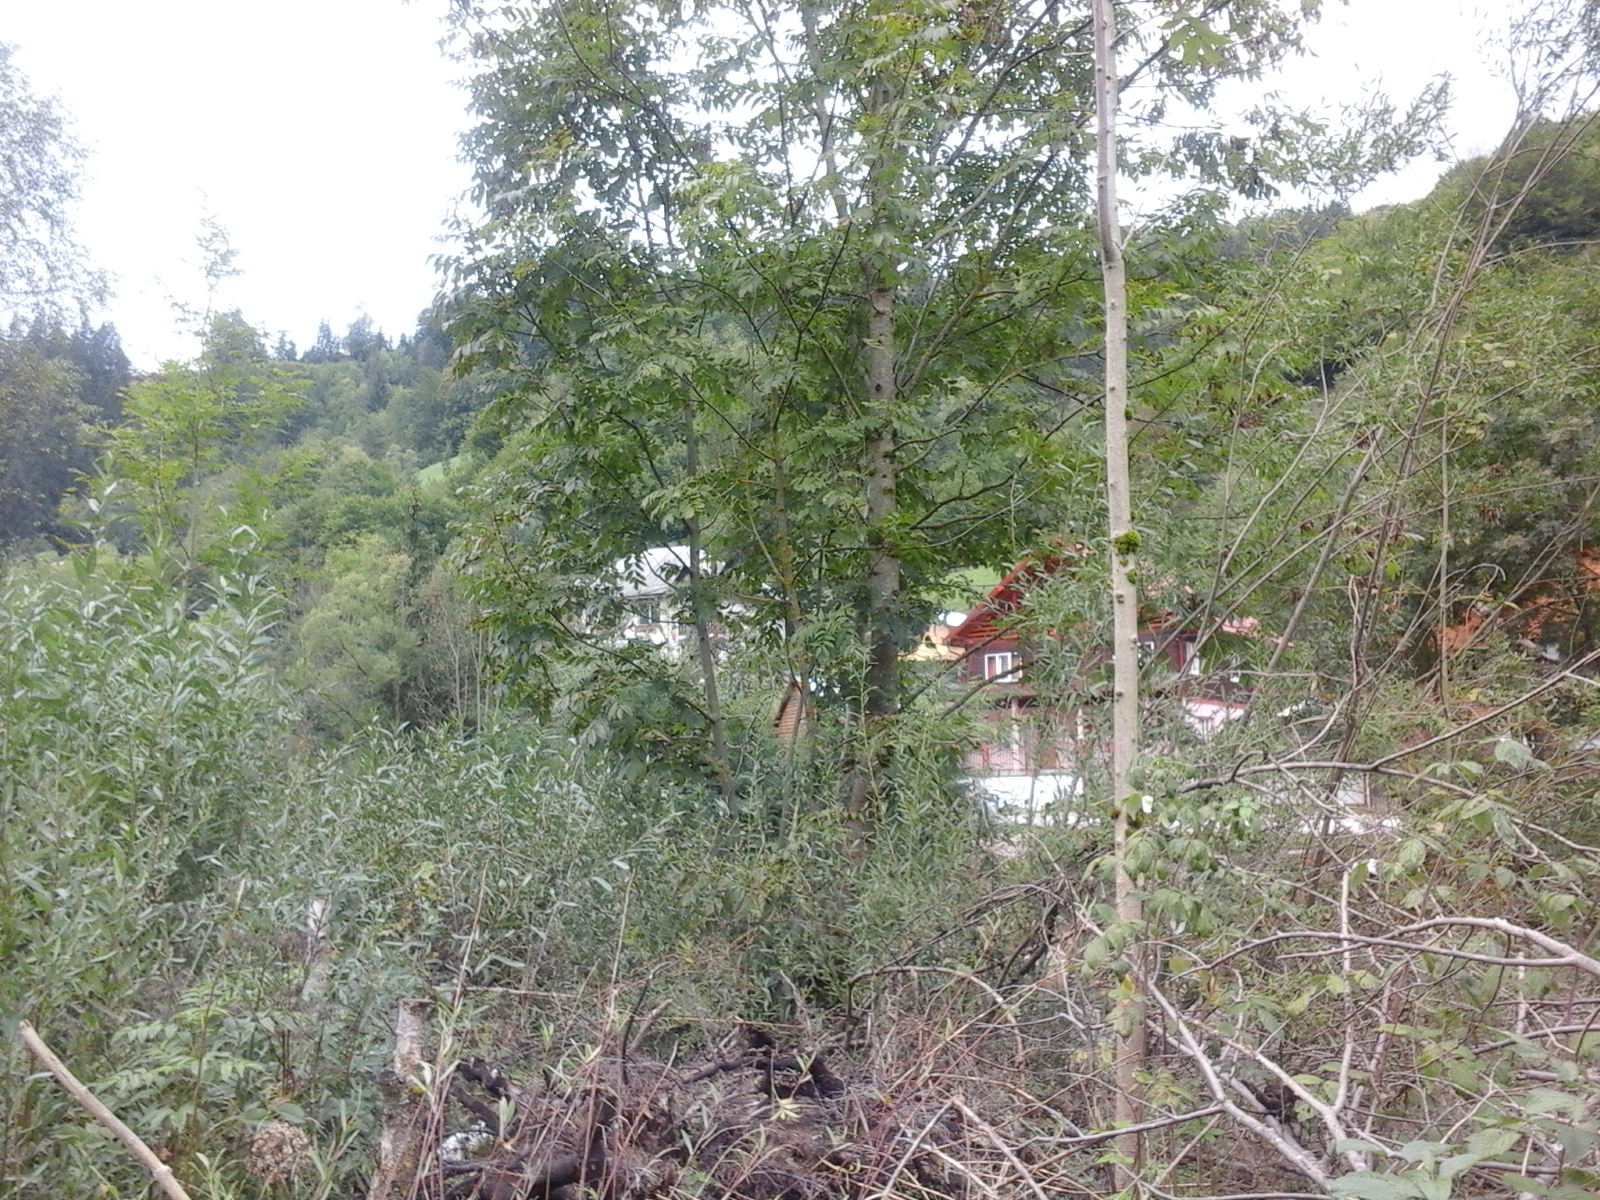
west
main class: Grassland
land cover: Spontaneously vegetated surfaces
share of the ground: > 75 %
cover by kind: herbaceous plants 100 %
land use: Semi-natural and natural areas not in use
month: September
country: RO
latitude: 46.4616
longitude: 22.8829
